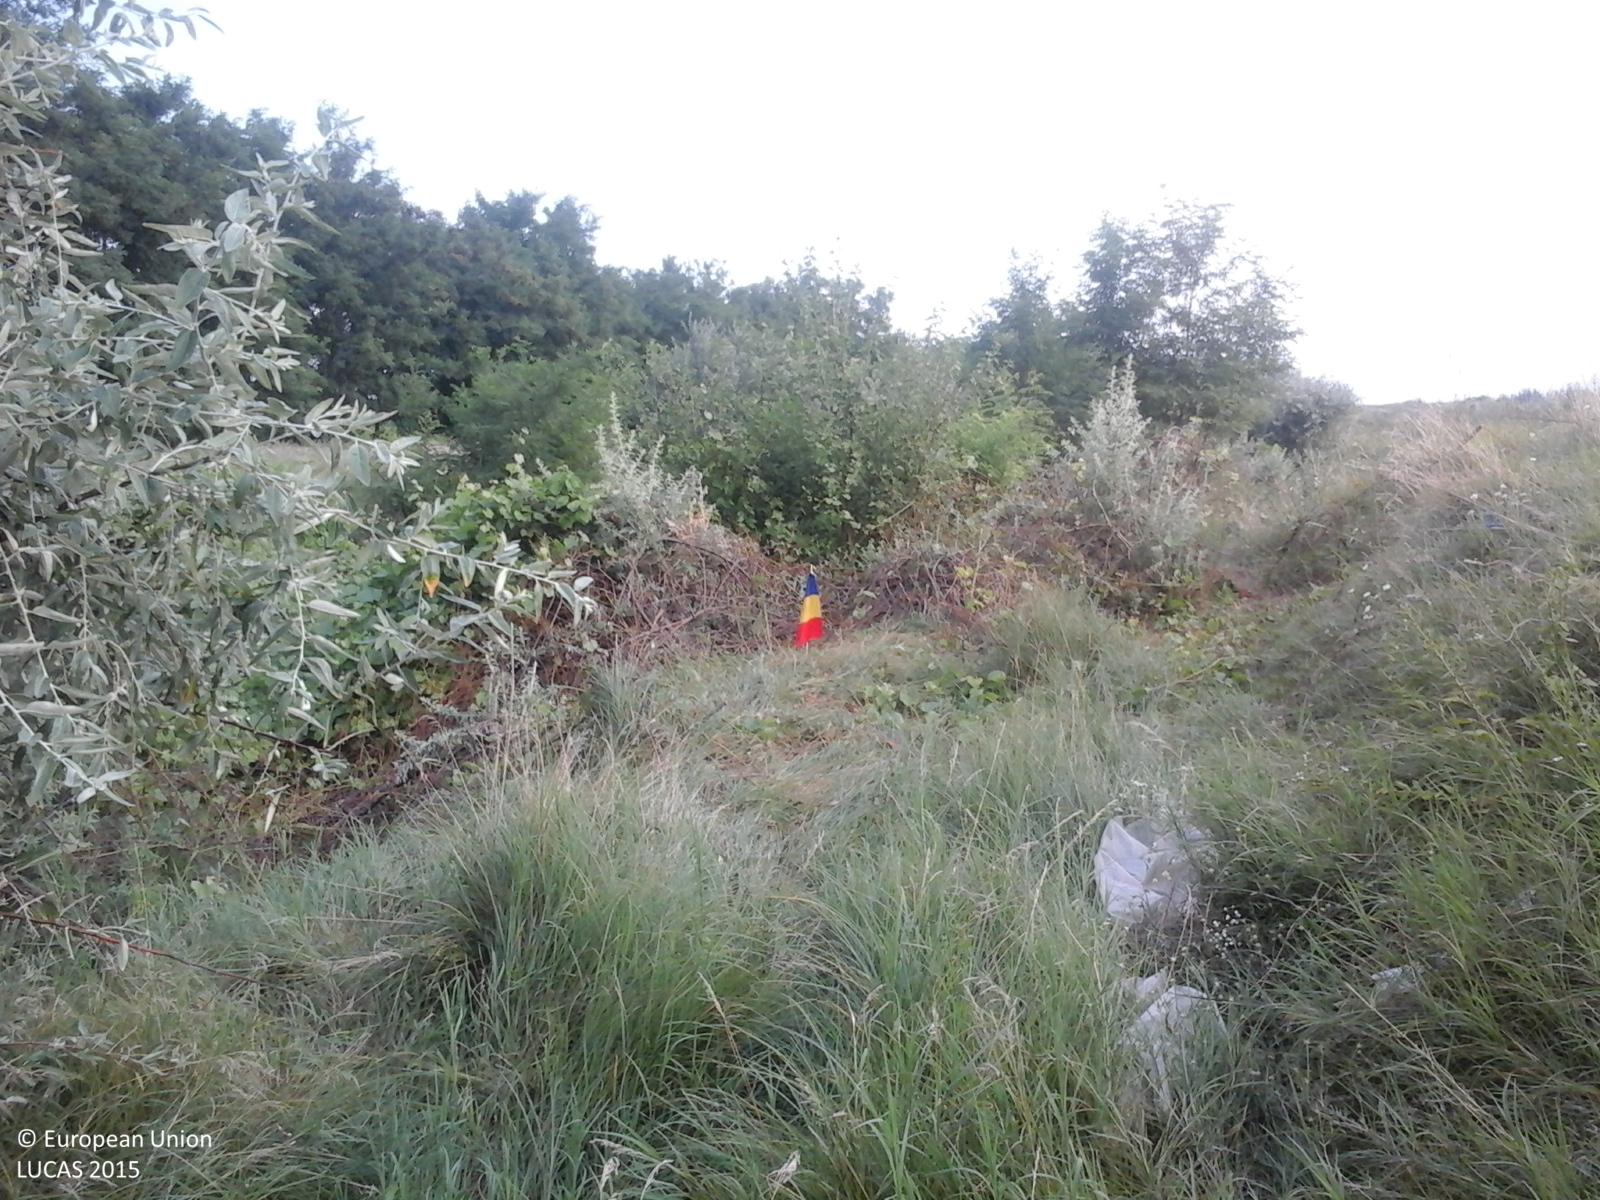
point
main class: Grassland
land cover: Spontaneously vegetated surfaces
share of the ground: > 75 %
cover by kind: herbaceous plants 100 %
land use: Agriculture (excluding fallow land and kitchen gardens)
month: July
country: RO
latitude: 43.8150
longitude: 24.1441
